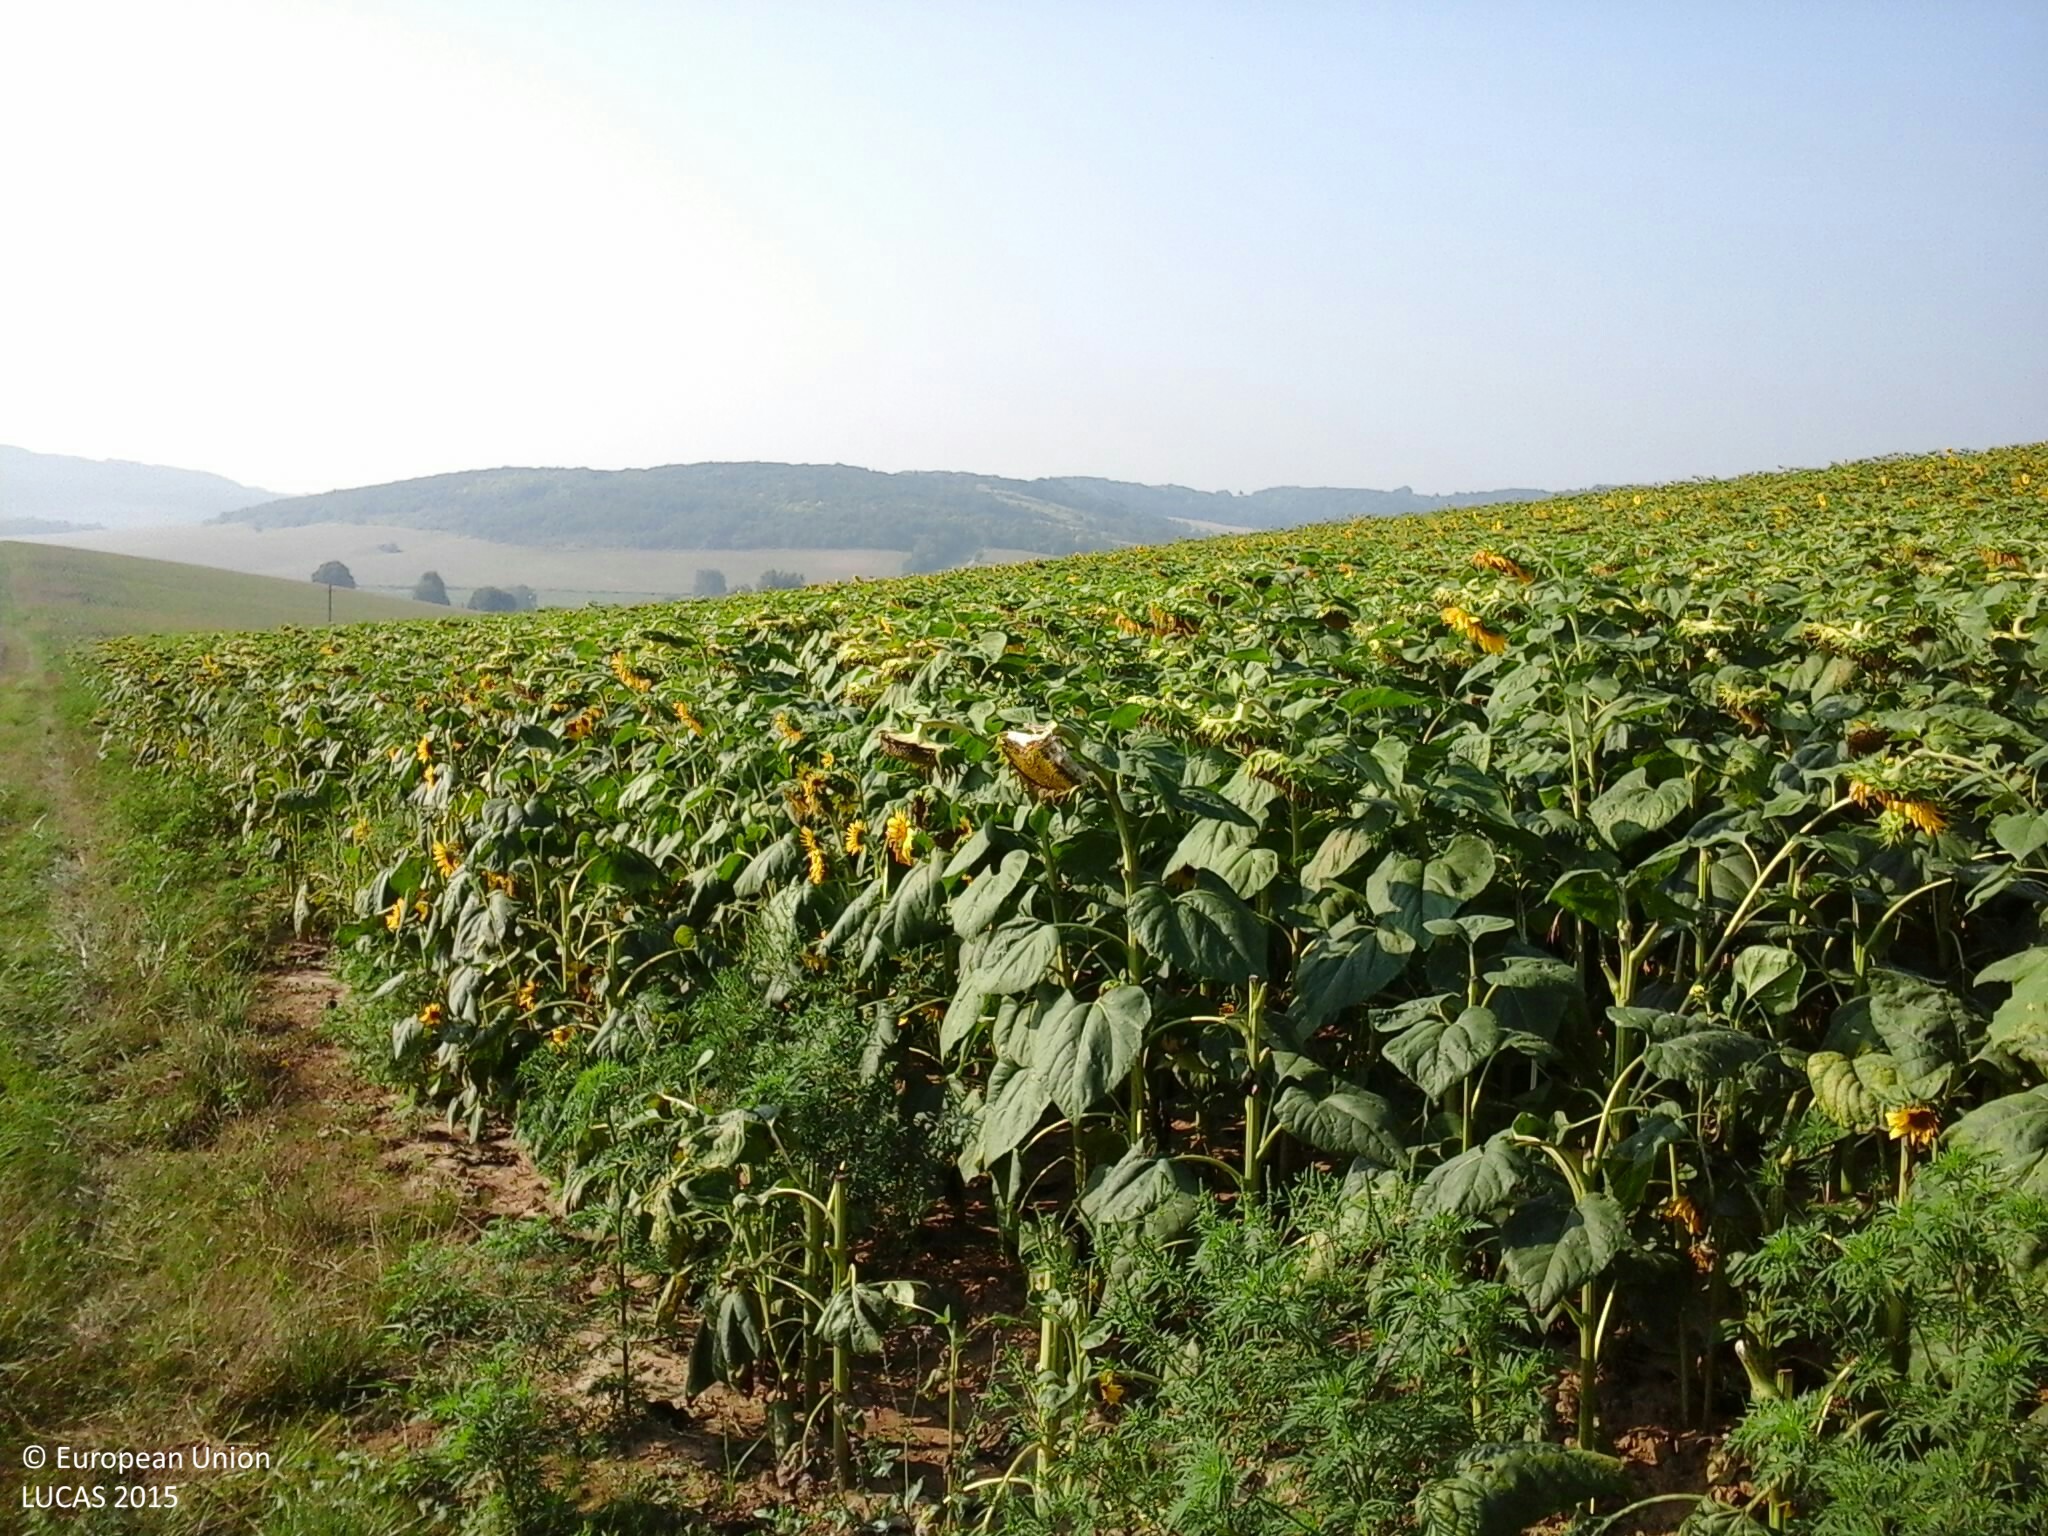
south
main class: Cropland
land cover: Sunflower
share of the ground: > 75 %
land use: Agriculture (excluding fallow land and kitchen gardens)
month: August
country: HU
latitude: 46.6074
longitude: 18.0637
